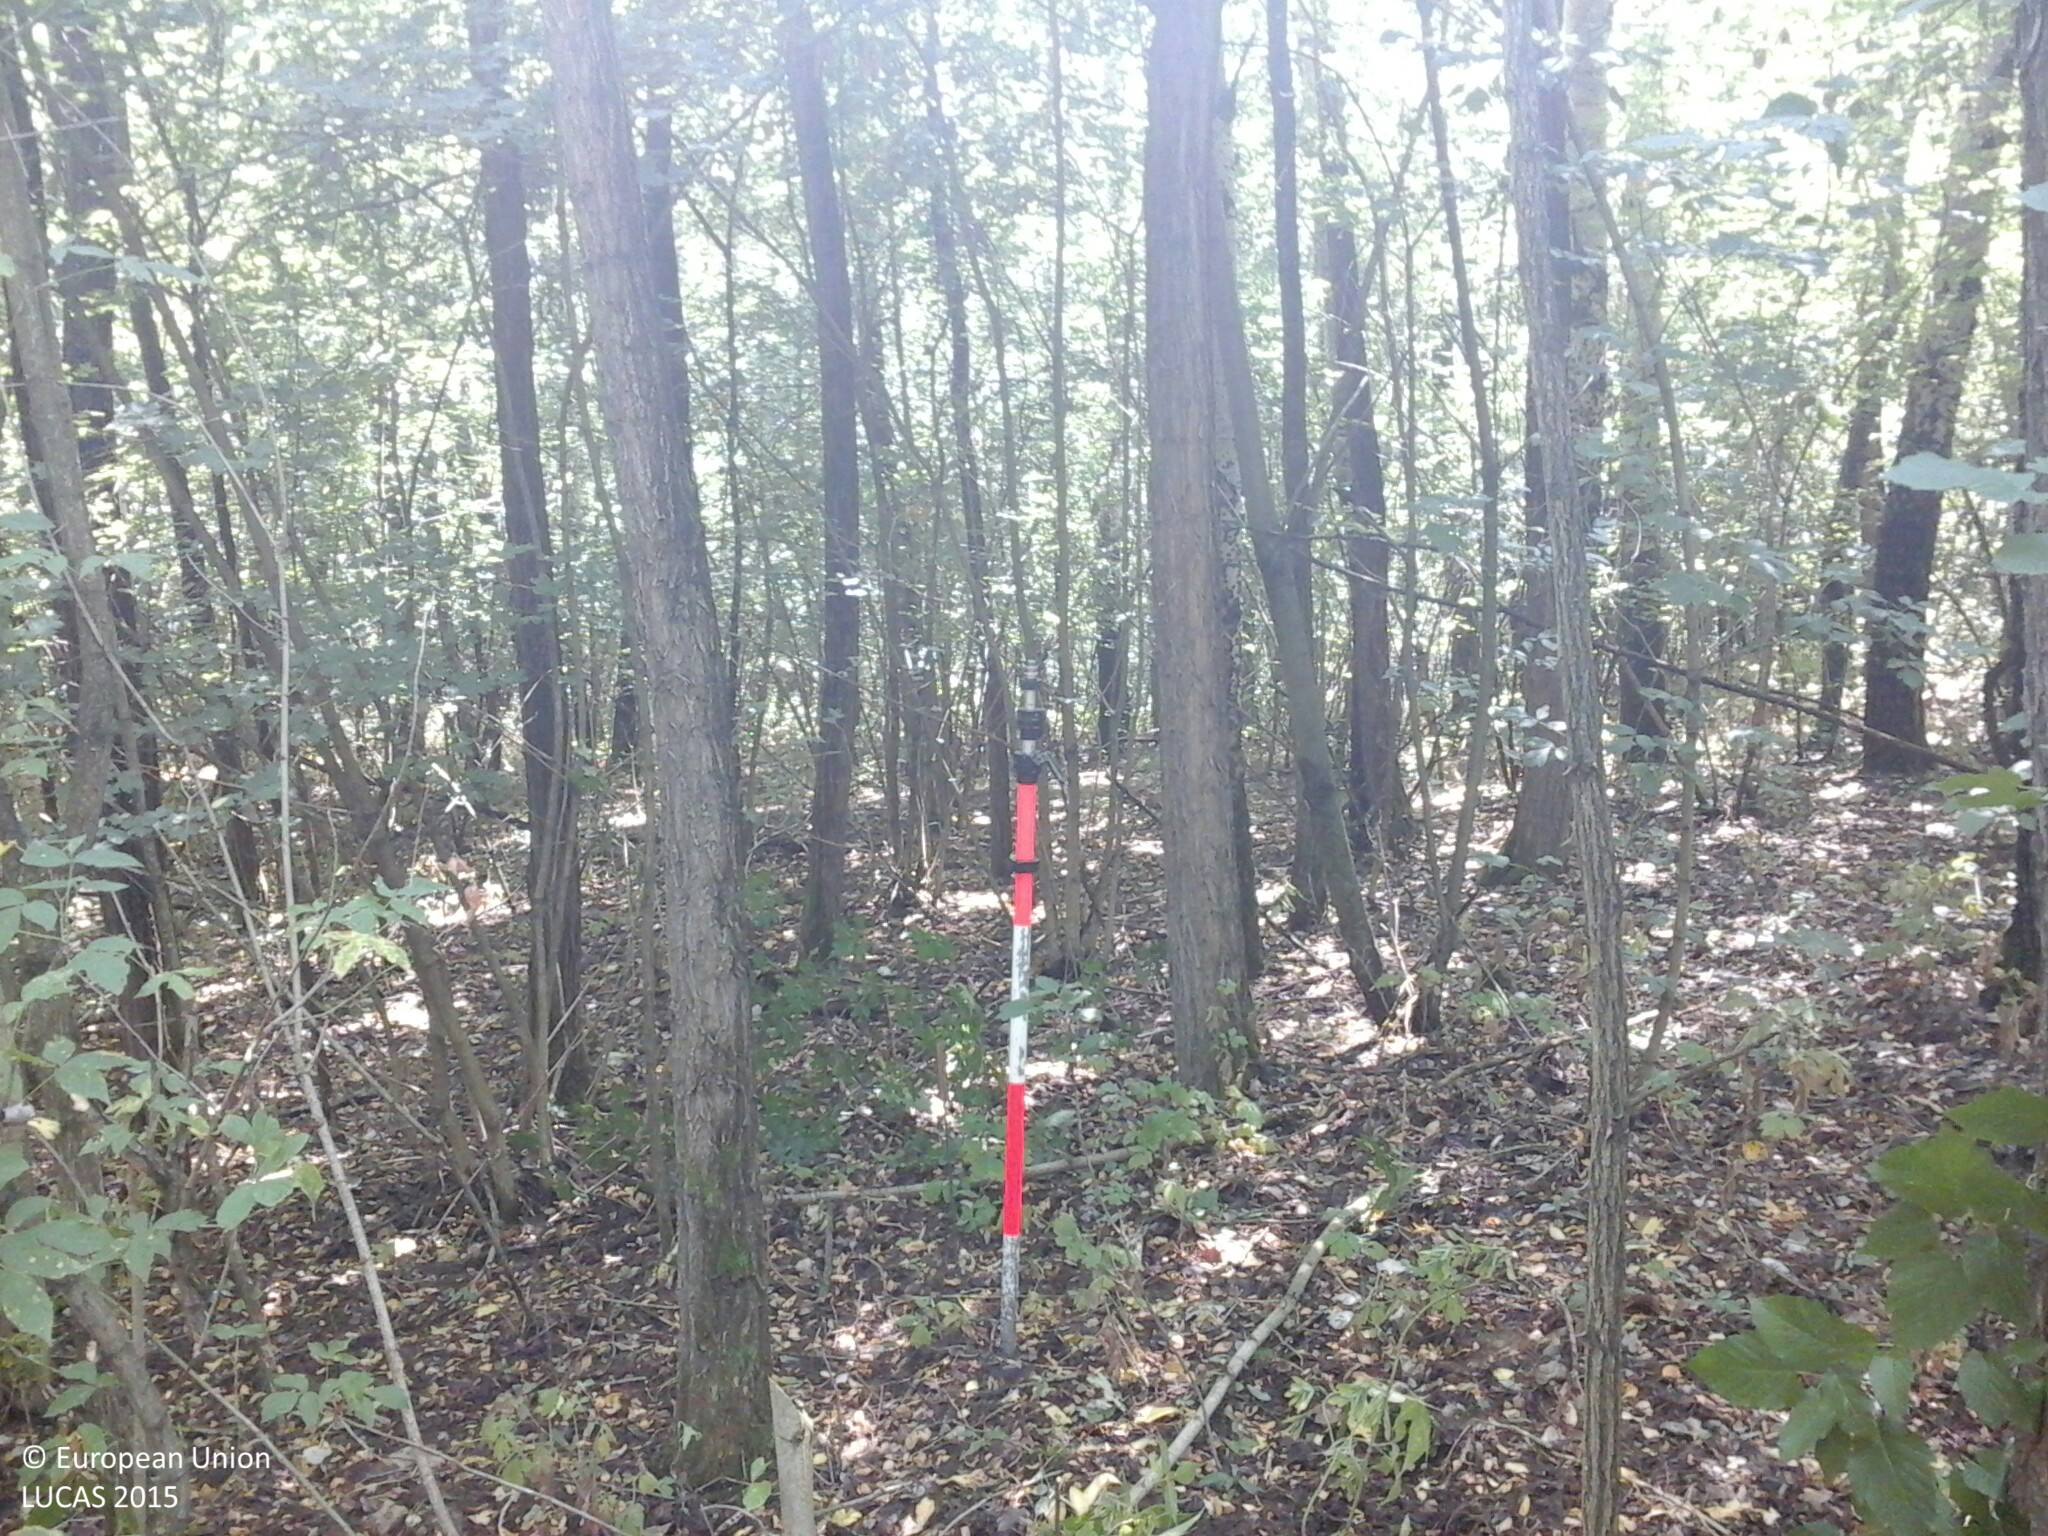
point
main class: Woodland
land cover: Broadleaved woodland
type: mesophytic deciduous forest
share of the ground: > 75 %
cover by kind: broadleaved forest trees 100 %
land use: Forestry
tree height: > 5 m
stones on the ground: < 10 %
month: July
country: HU
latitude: 48.2329
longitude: 22.2135
